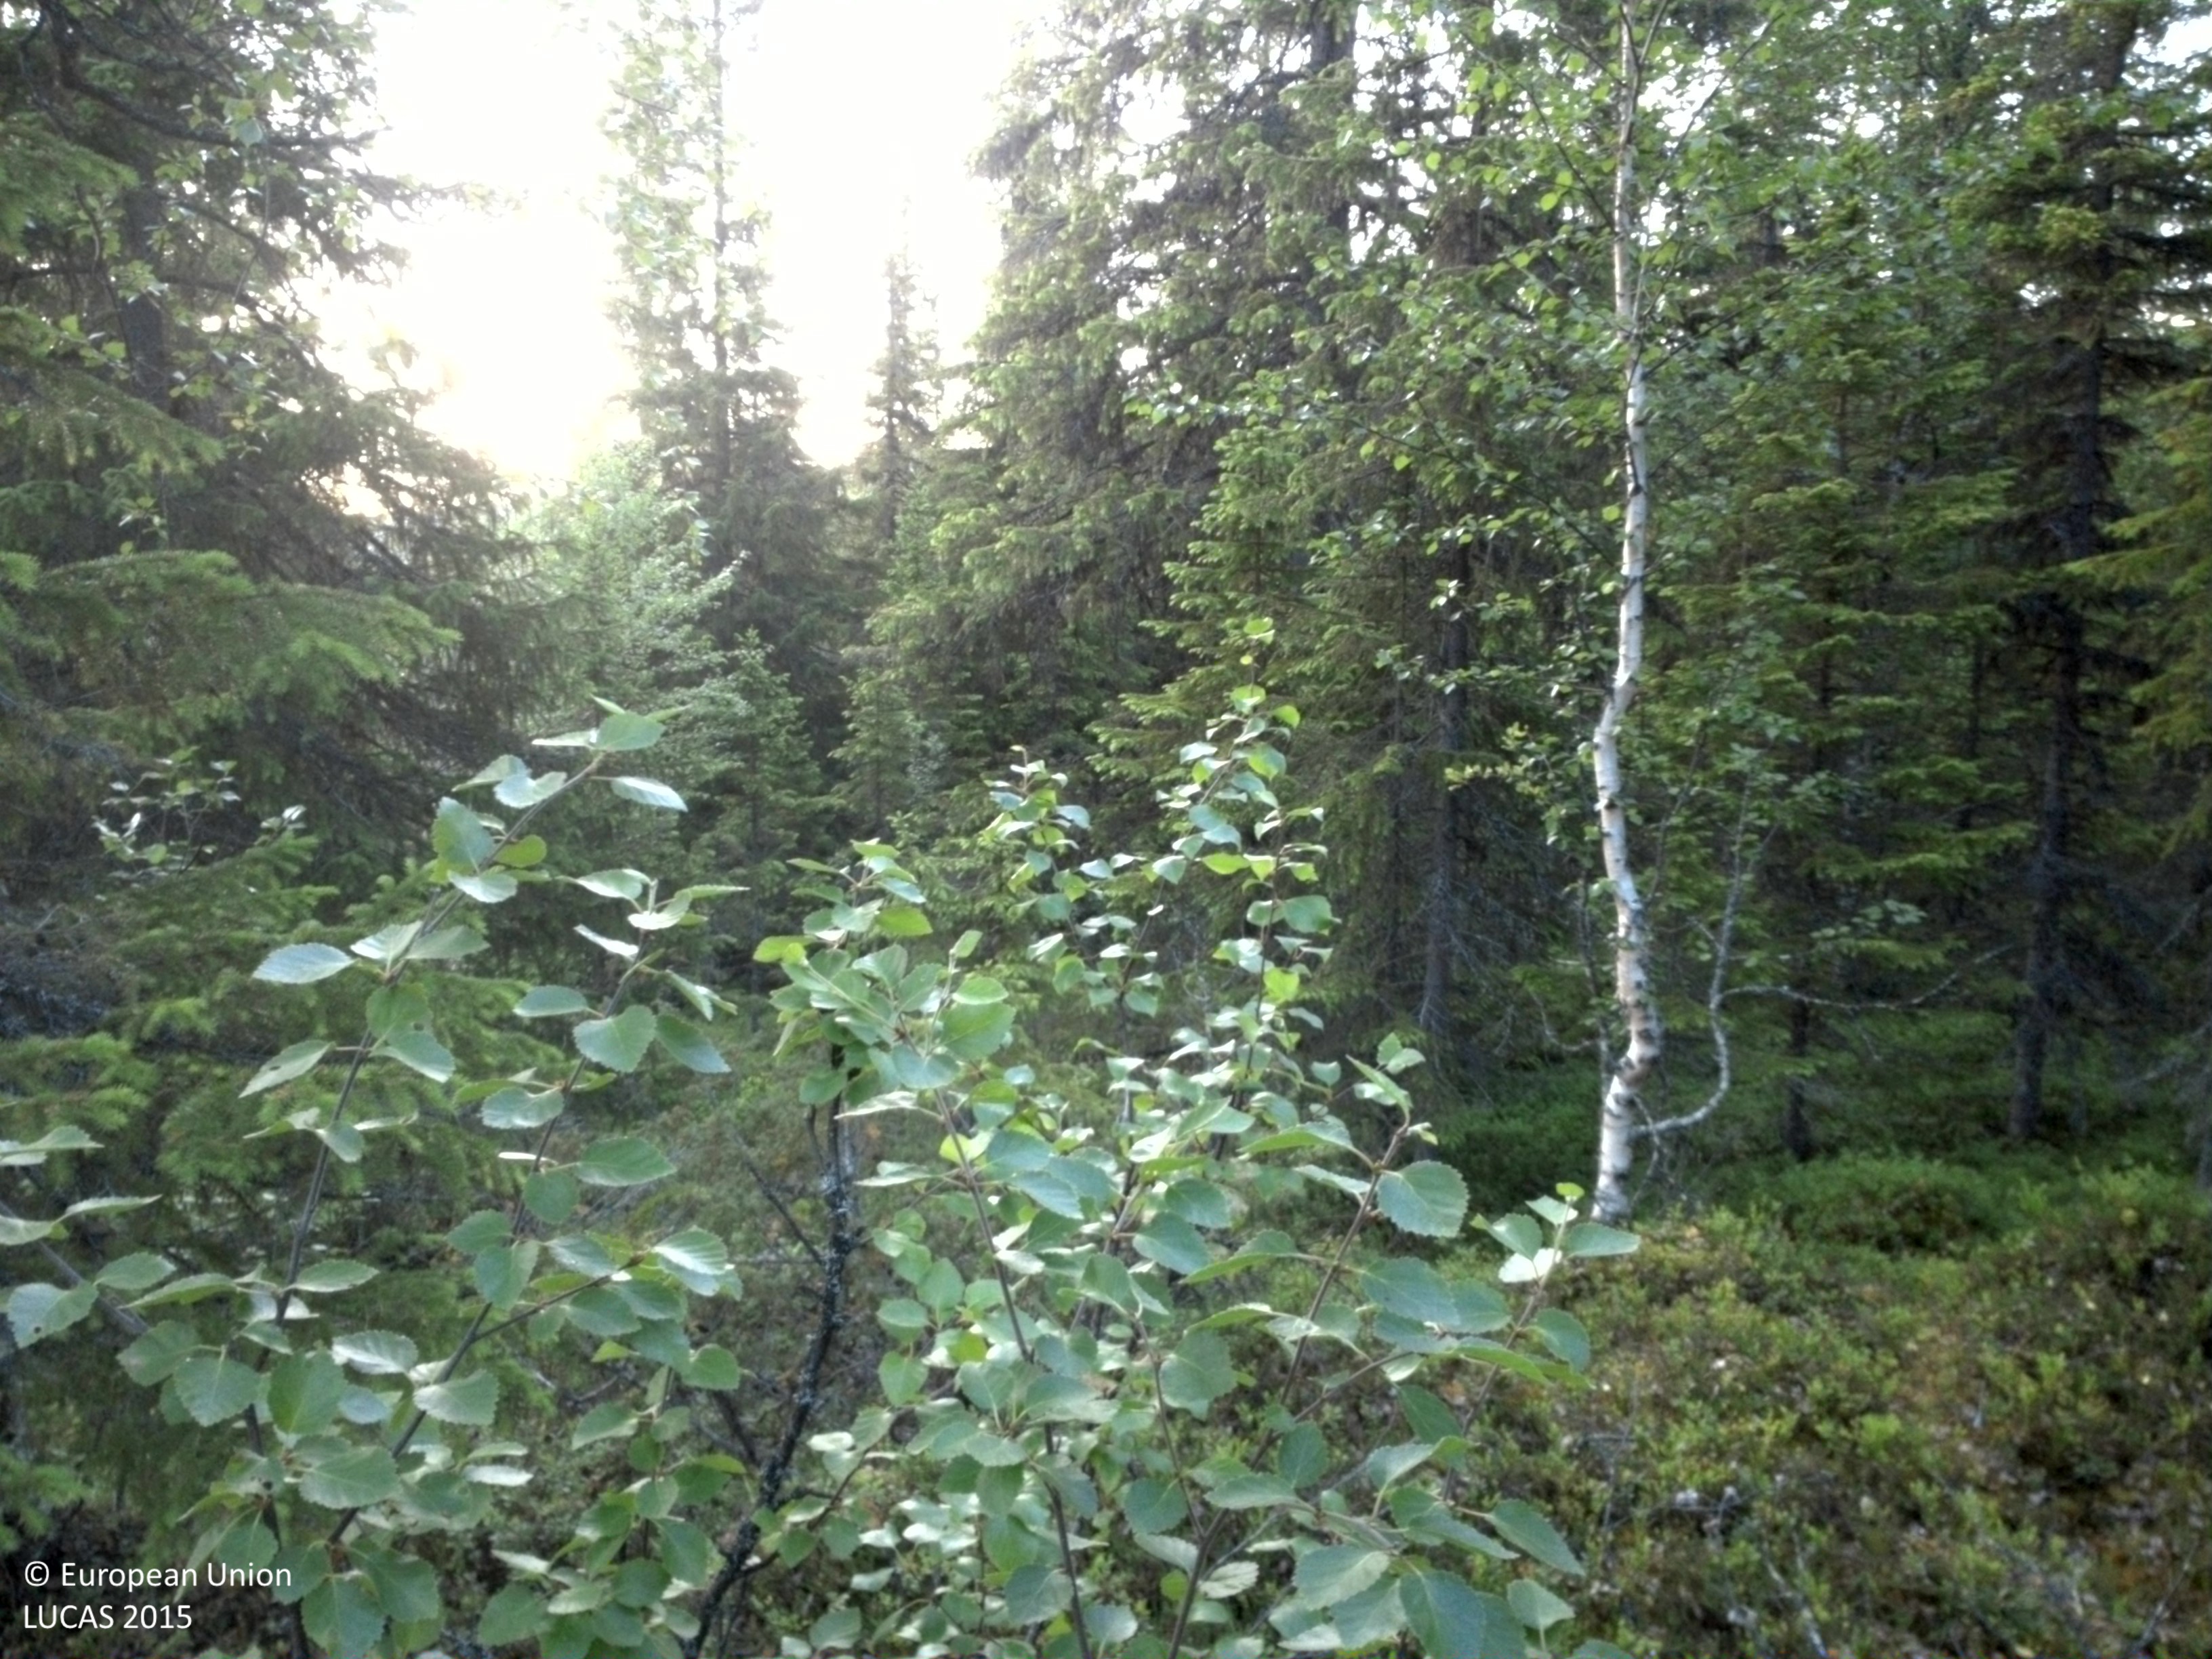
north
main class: Woodland
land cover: Spruce dominated mixed woodland
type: boreal forest
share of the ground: 25 - 50 %
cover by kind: shrubs 45 %, coniferous forest trees 25 %, broadleaved forest trees 20 %, lichens and mosses 10 %
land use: Forestry
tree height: > 5 m
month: July
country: SE
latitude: 65.5365
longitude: 15.4400
